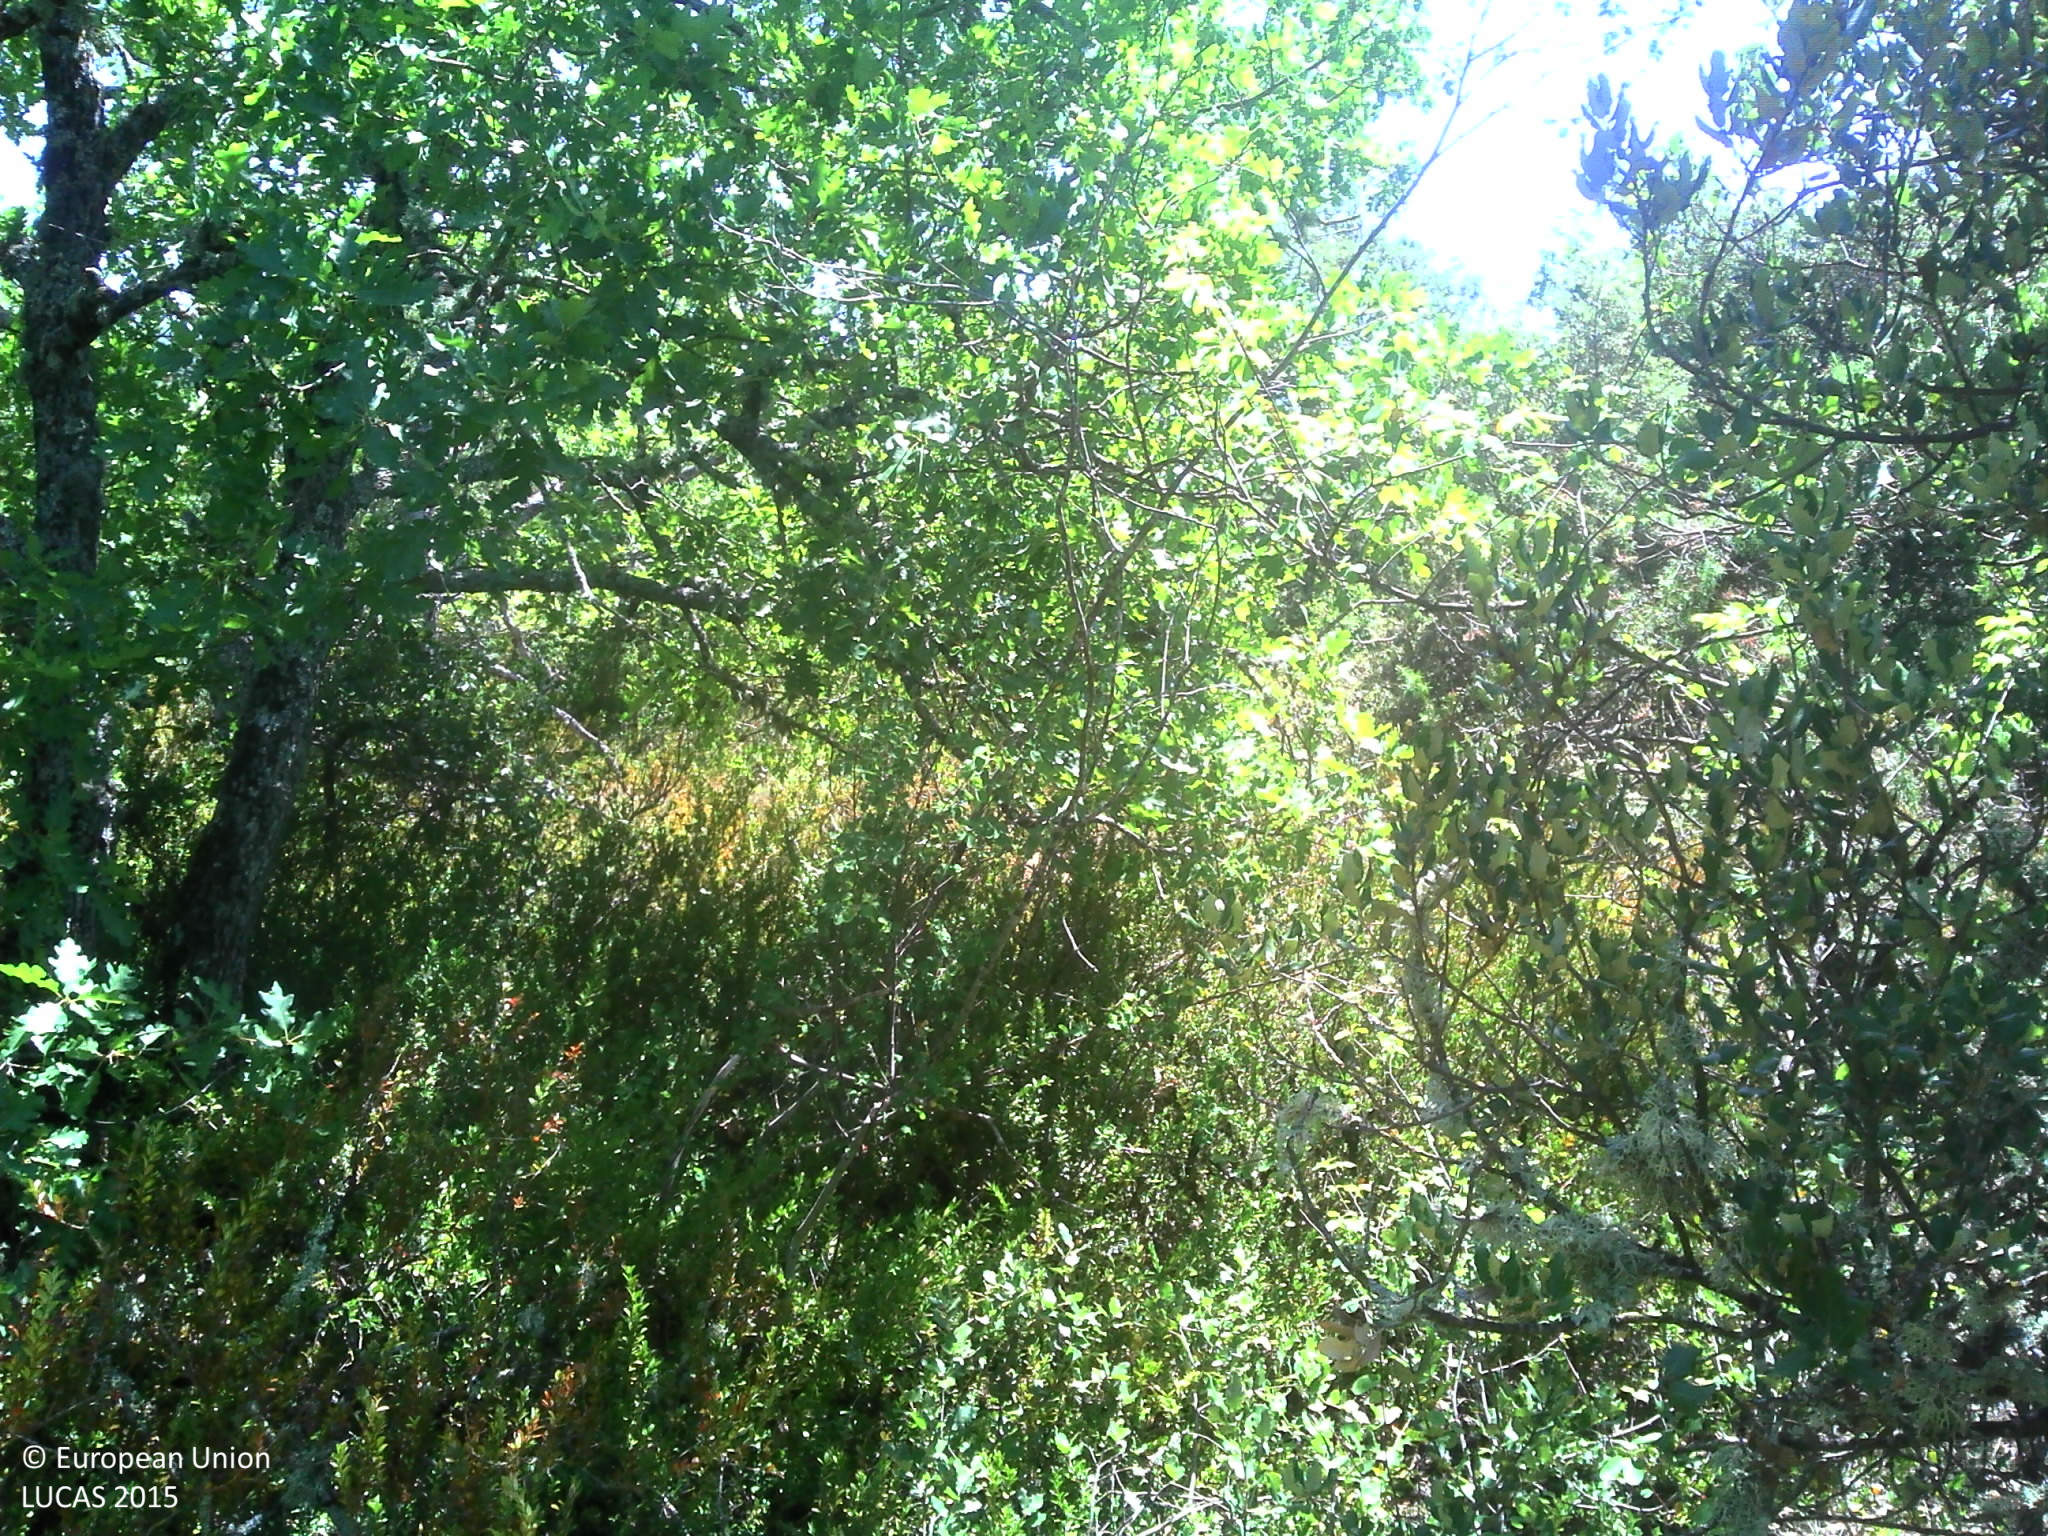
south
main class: Woodland
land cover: Broadleaved woodland
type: thermophilous deciduous forest
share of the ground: 50 - 75 %
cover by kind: broadleaved forest trees 75 %, shrubs 25 %
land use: Forestry
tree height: > 5 m
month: July
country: FR
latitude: 43.9316
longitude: 5.5864
